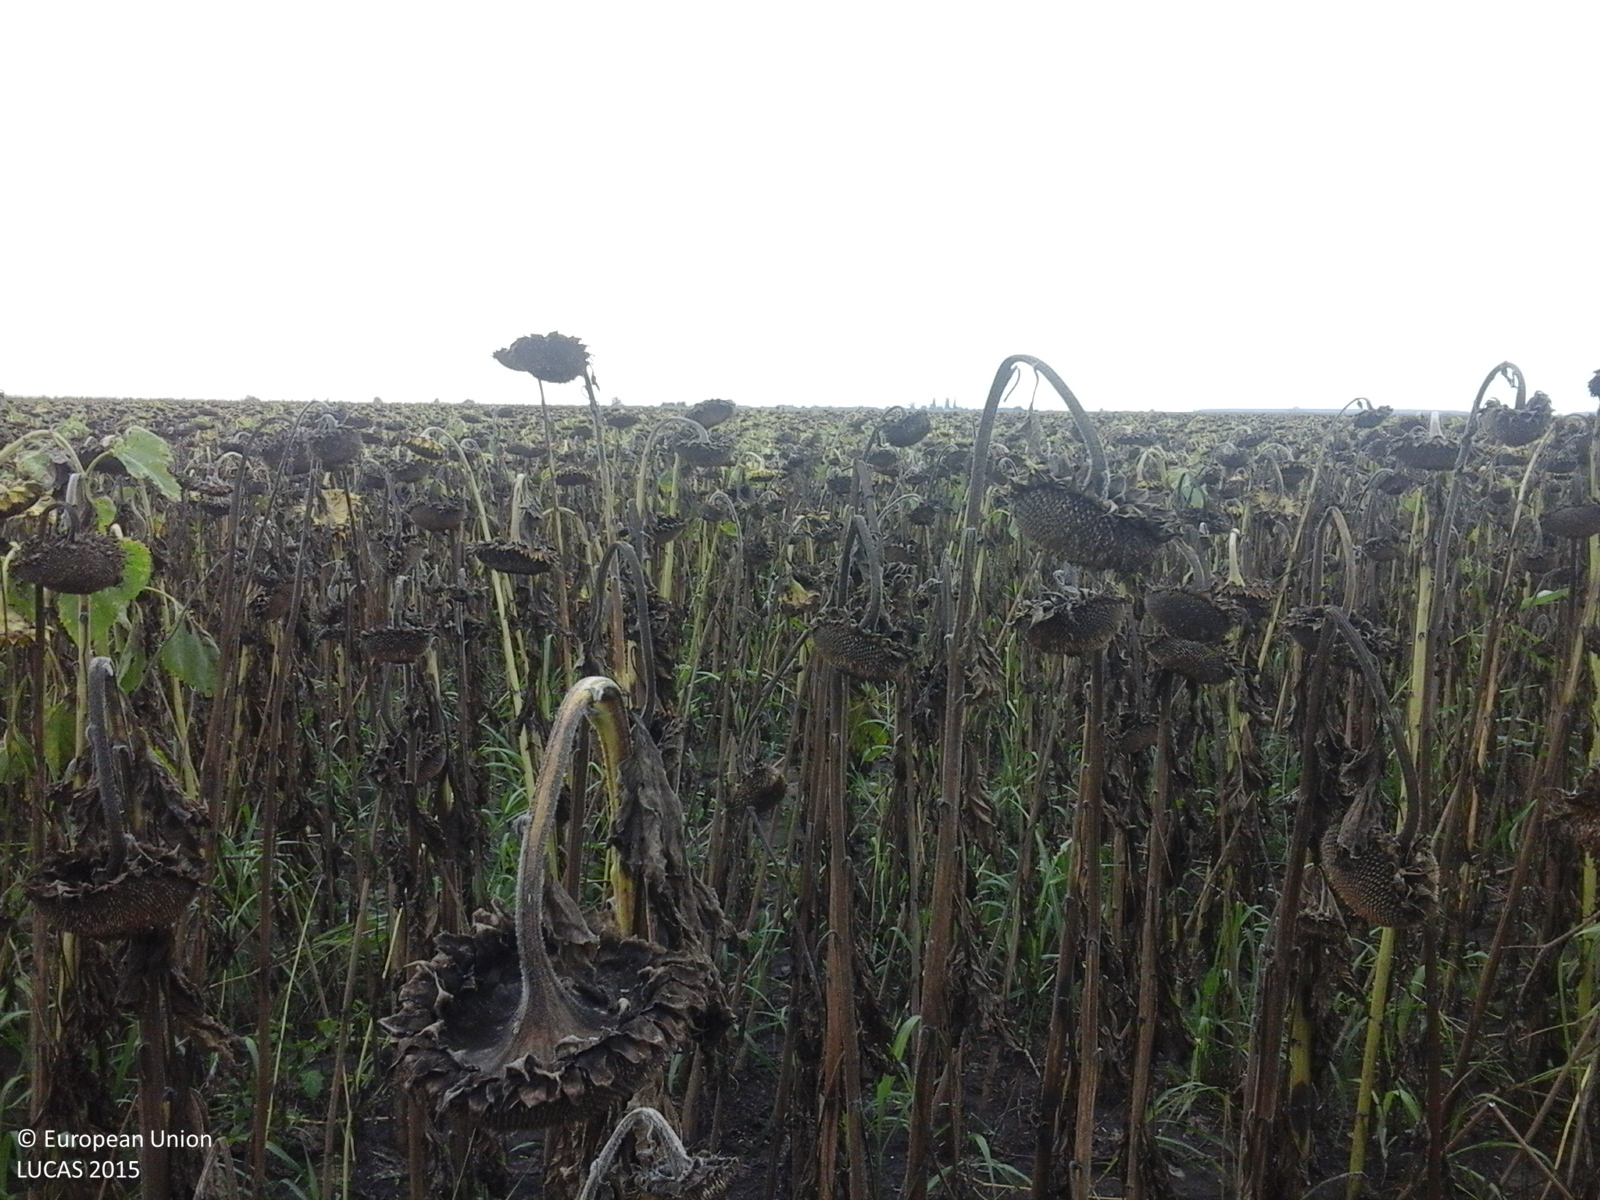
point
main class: Cropland
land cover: Sunflower
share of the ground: > 75 %
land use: Agriculture (excluding fallow land and kitchen gardens)
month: August
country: RO
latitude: 46.2872
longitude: 21.2087
